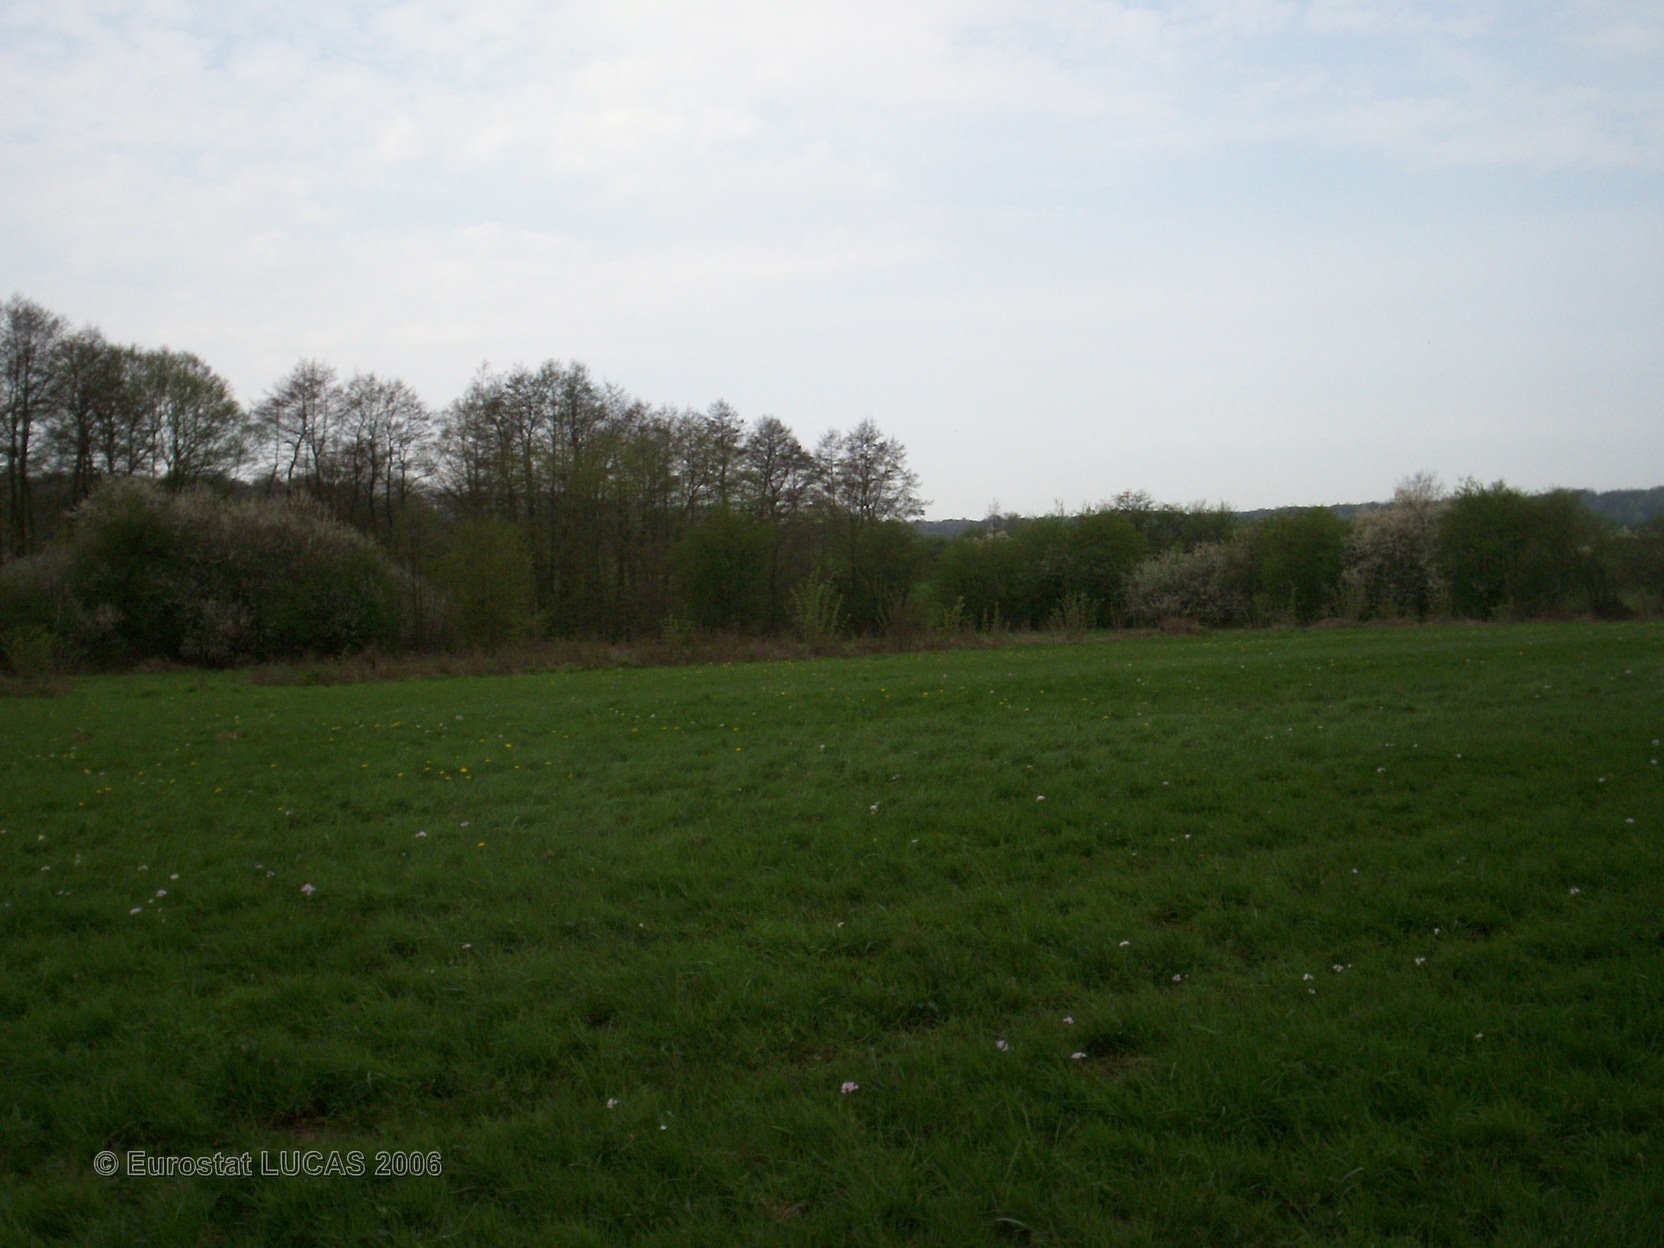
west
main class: Grassland
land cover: Grassland without tree/shrub cover
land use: Agriculture (excluding fallow land and kitchen gardens)
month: May
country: FR
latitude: 49.8961
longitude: 4.2738
